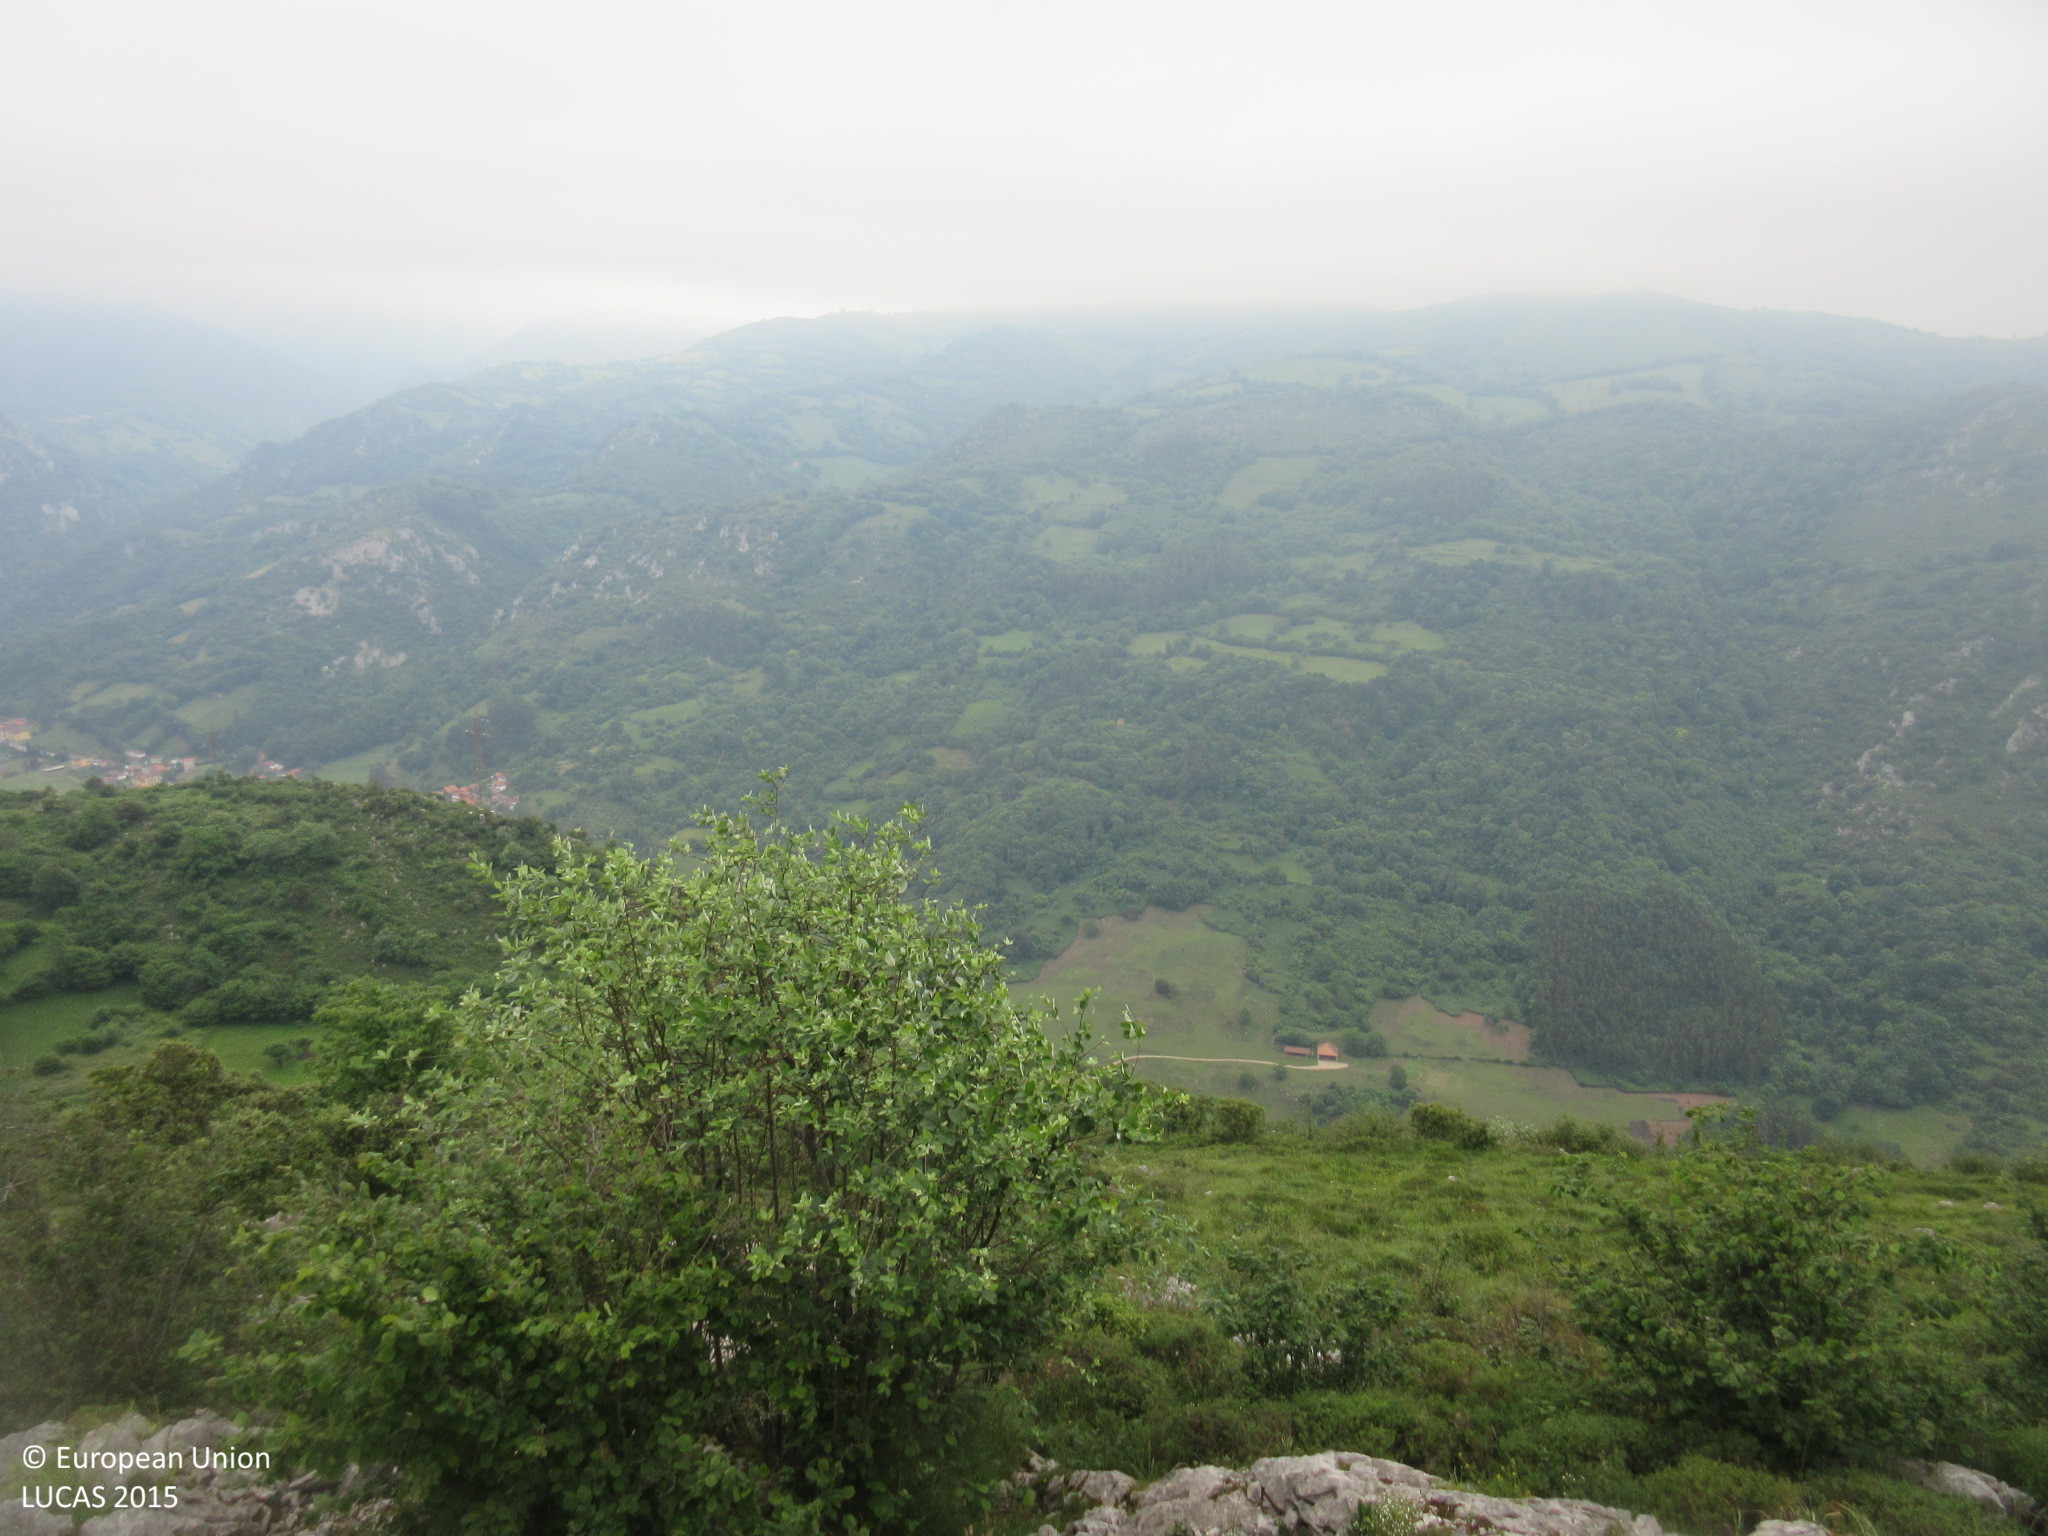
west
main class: Woodland
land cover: Broadleaved woodland
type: broadleaved evergreen forest
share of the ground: 50 - 75 %
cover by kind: broadleaved forest trees 55 %, consolidated bare surface 30 %, shrubs 15 %
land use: Semi-natural and natural areas not in use
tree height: < 5 m
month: June
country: ES
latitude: 43.2654
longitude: -5.9949
